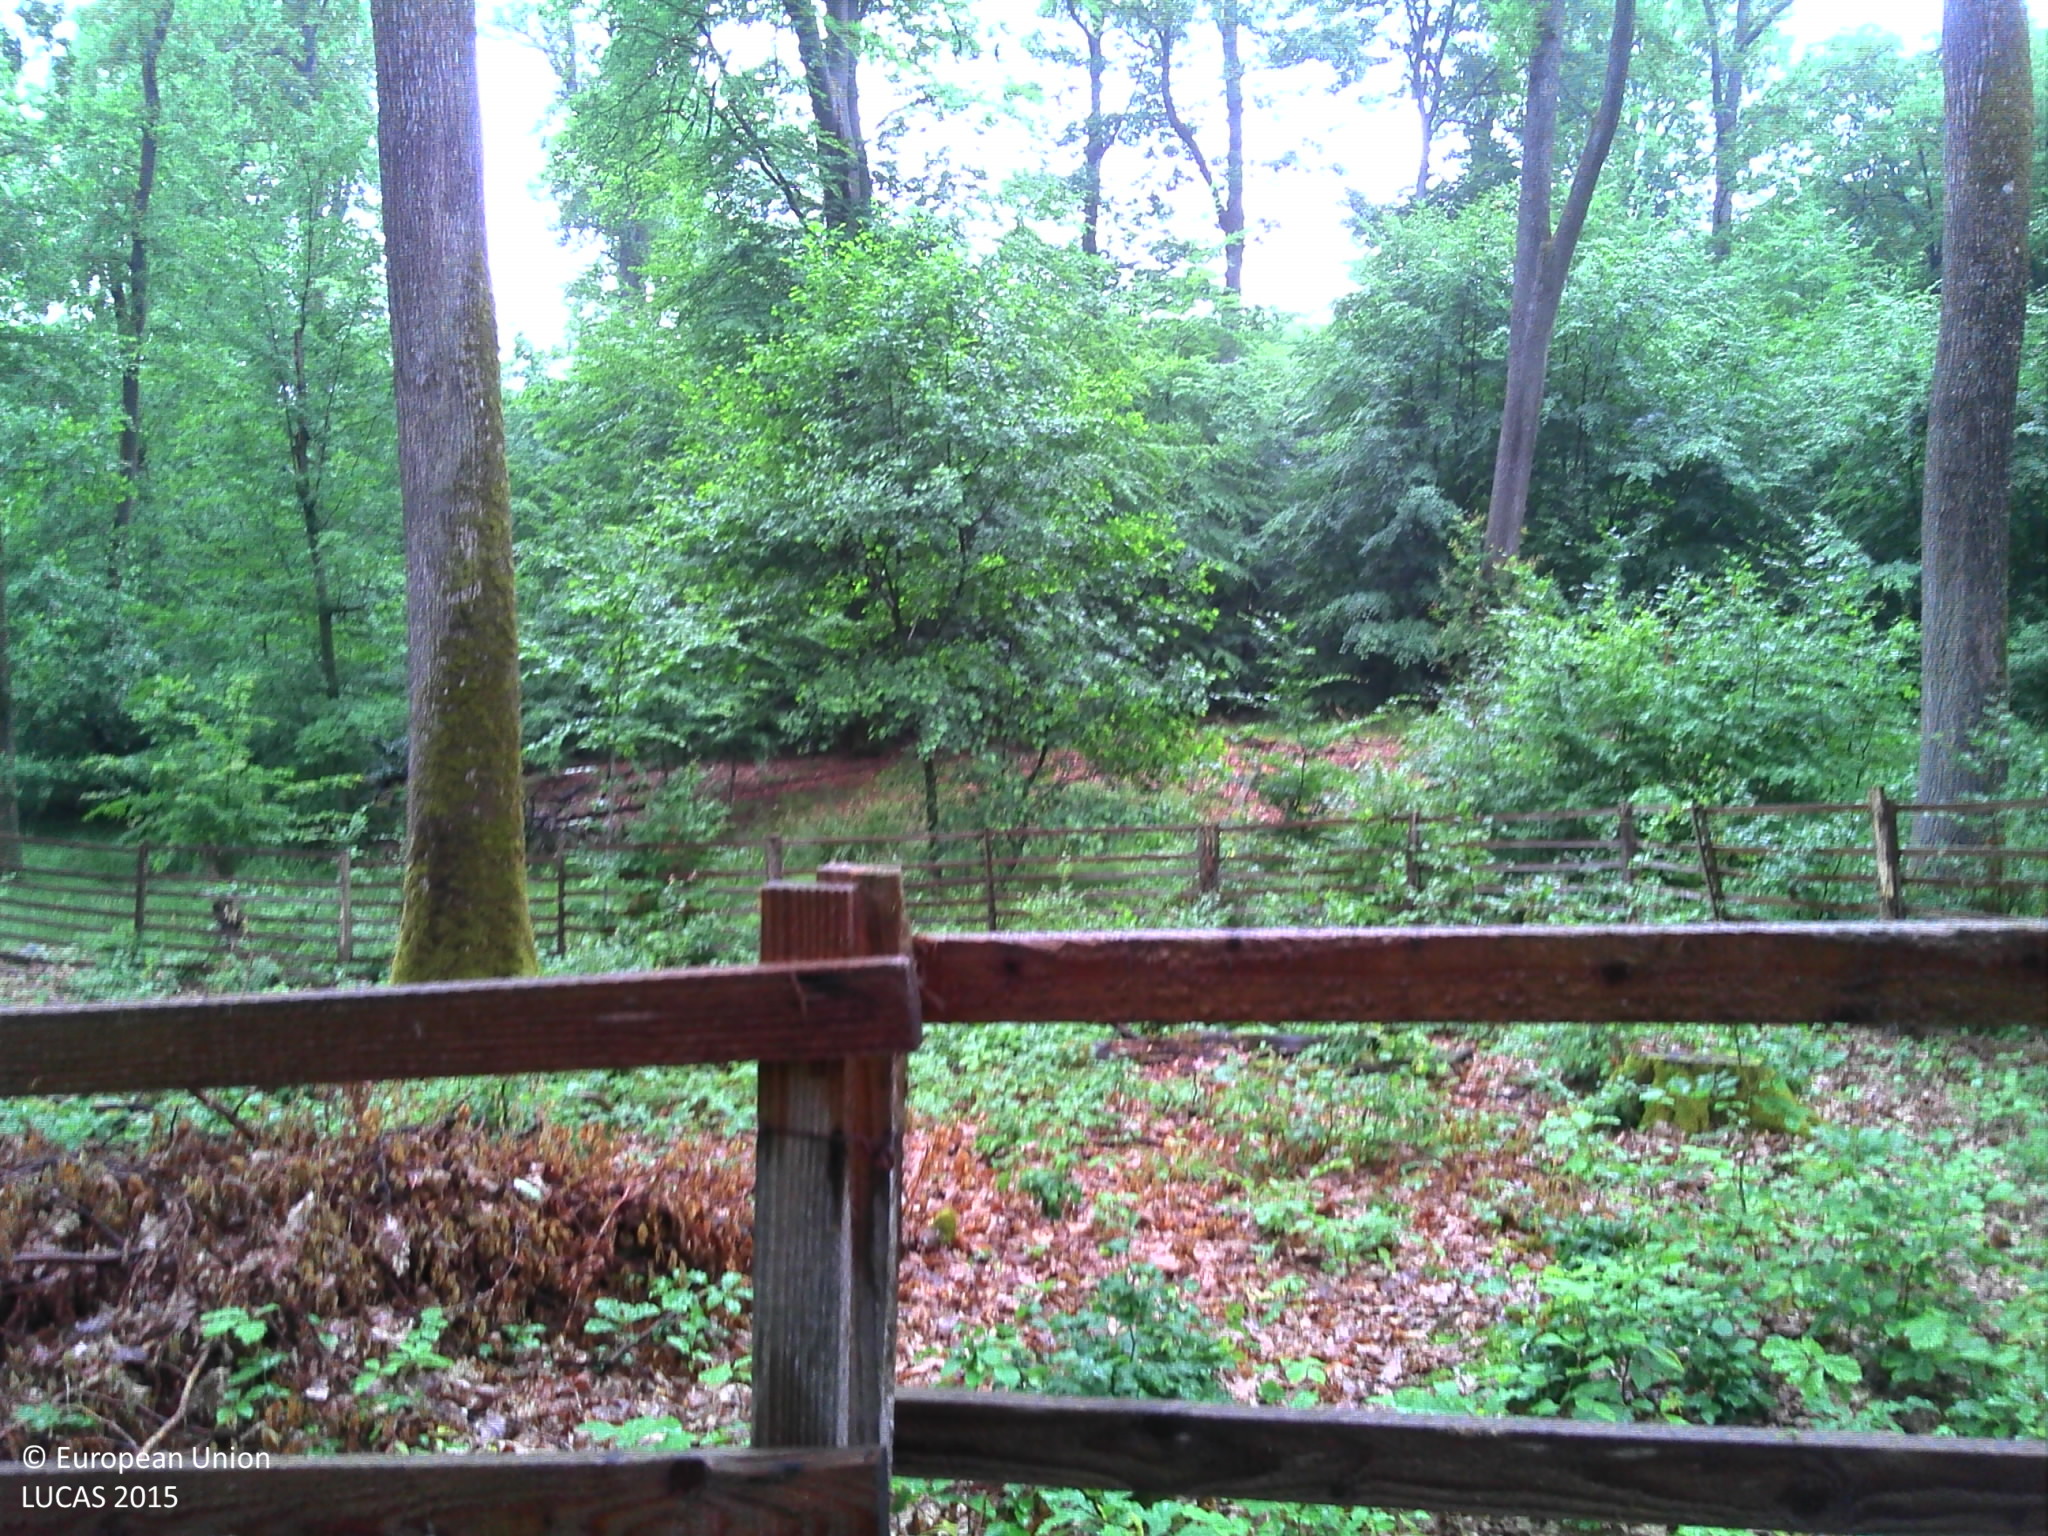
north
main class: Woodland
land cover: Broadleaved woodland
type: beech forest
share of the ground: > 75 %
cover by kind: broadleaved forest trees 90 %, shrubs 5 %, herbaceous plants 5 %
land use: Forestry
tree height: > 5 m
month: June
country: FR
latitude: 48.9750
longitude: 7.7737
